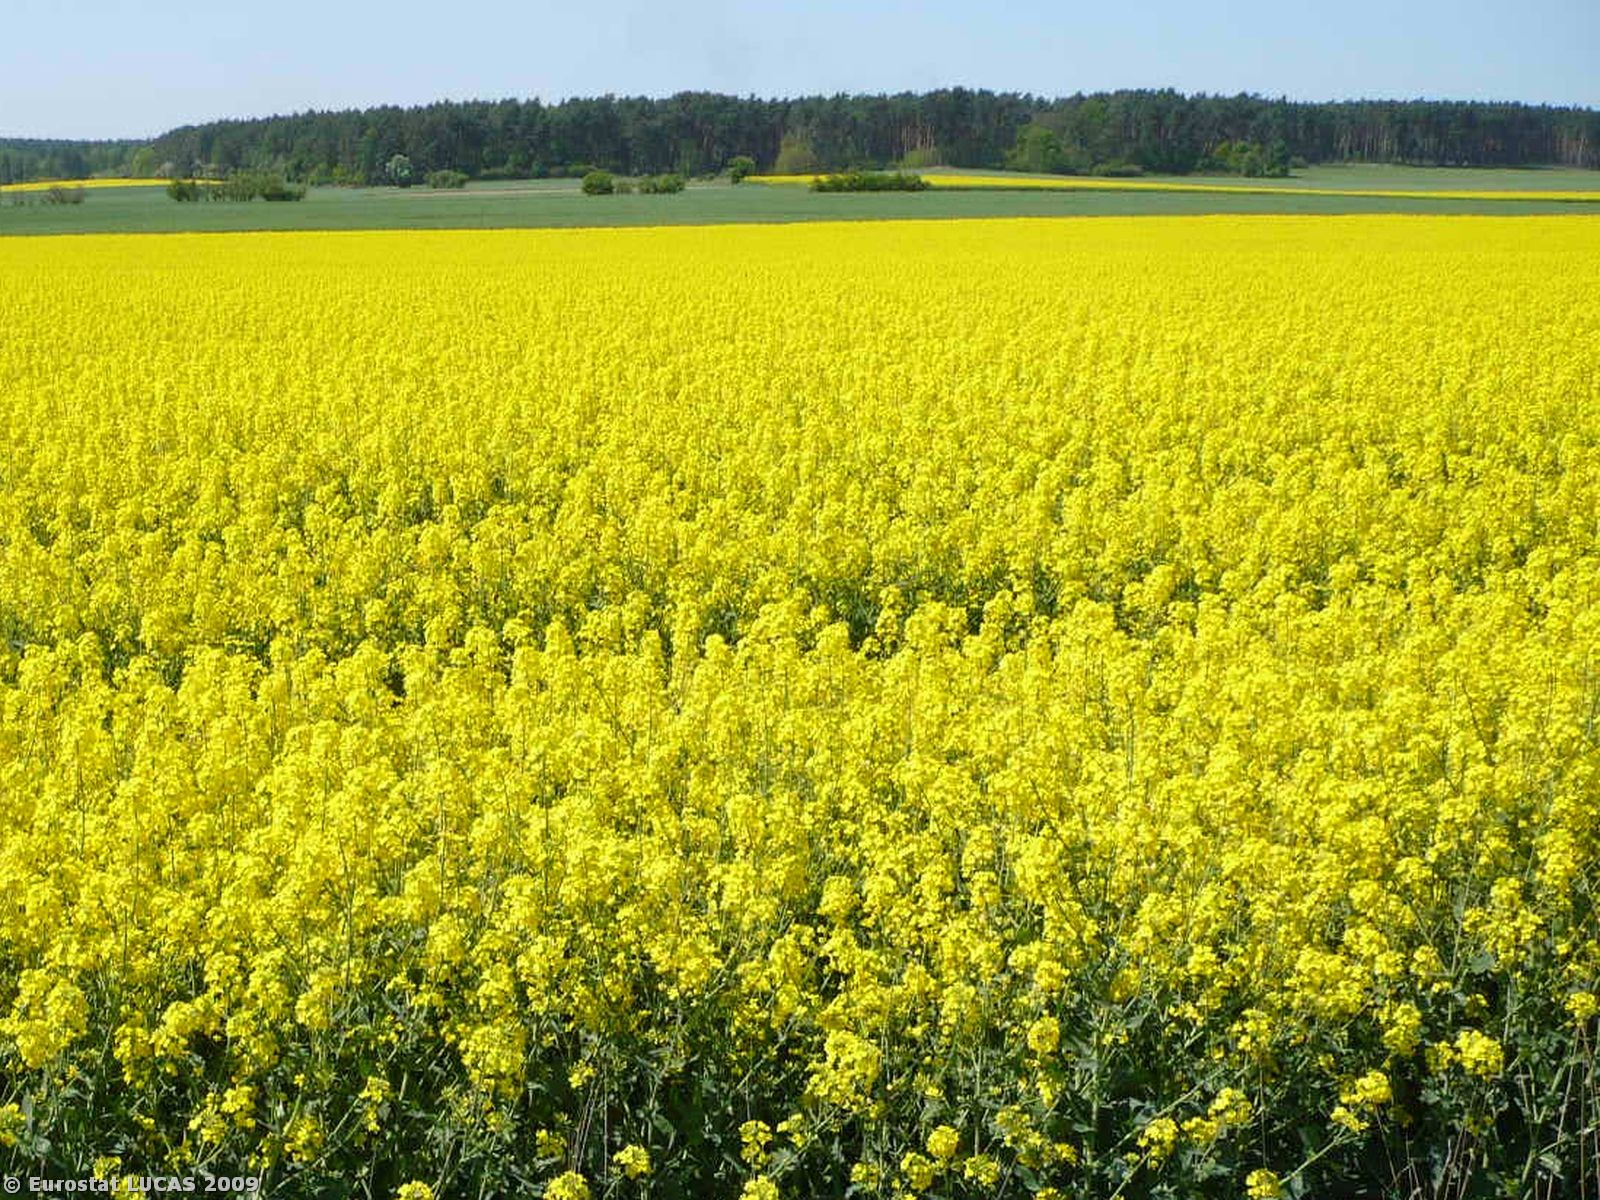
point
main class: Cropland
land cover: Rape and turnip rape
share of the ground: > 75 %
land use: Agriculture (excluding fallow land and kitchen gardens)
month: May
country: PL
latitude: 52.2226
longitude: 15.6991
